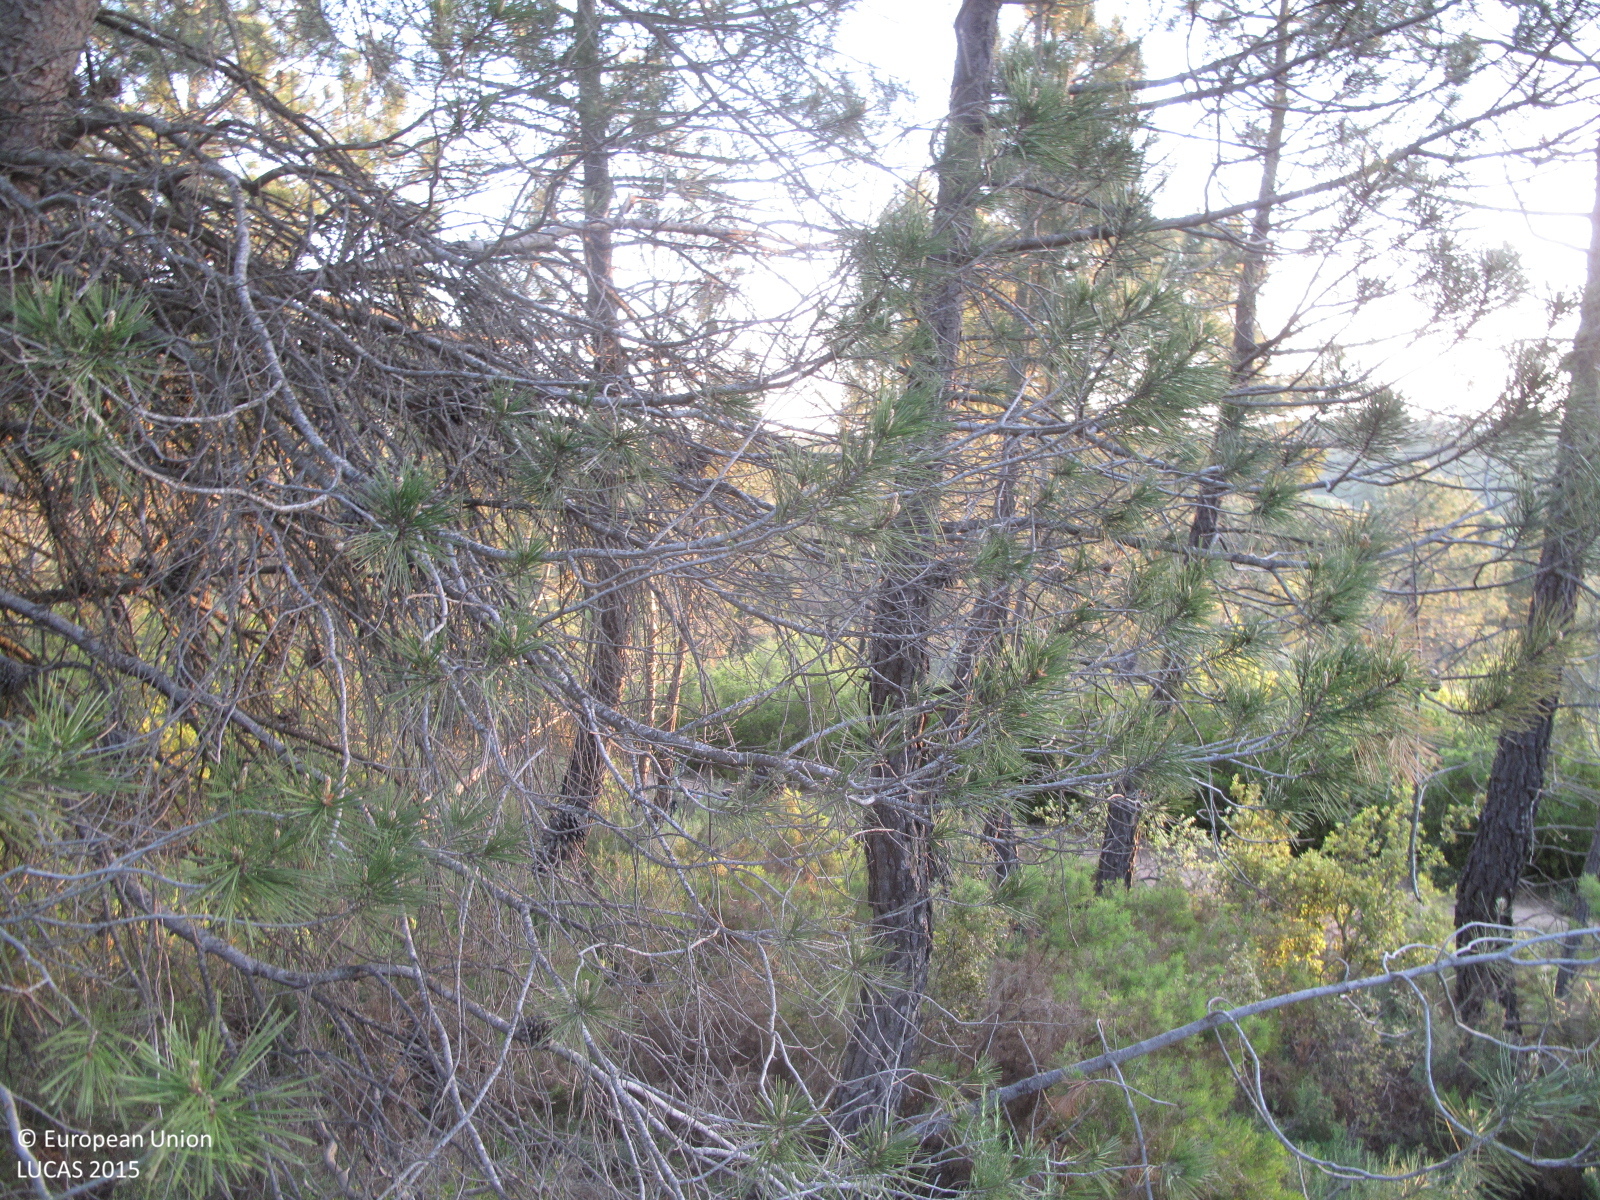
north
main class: Shrubland
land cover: Shrubland with sparse tree cover
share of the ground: 50 - 75 %
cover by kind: shrubs 50 %, herbaceous plants 30 %, consolidated bare surface 15 %, coniferous forest trees 5 %
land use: Semi-natural and natural areas not in use
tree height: > 5 m
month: May
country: ES
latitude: 38.9542
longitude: -0.9915
